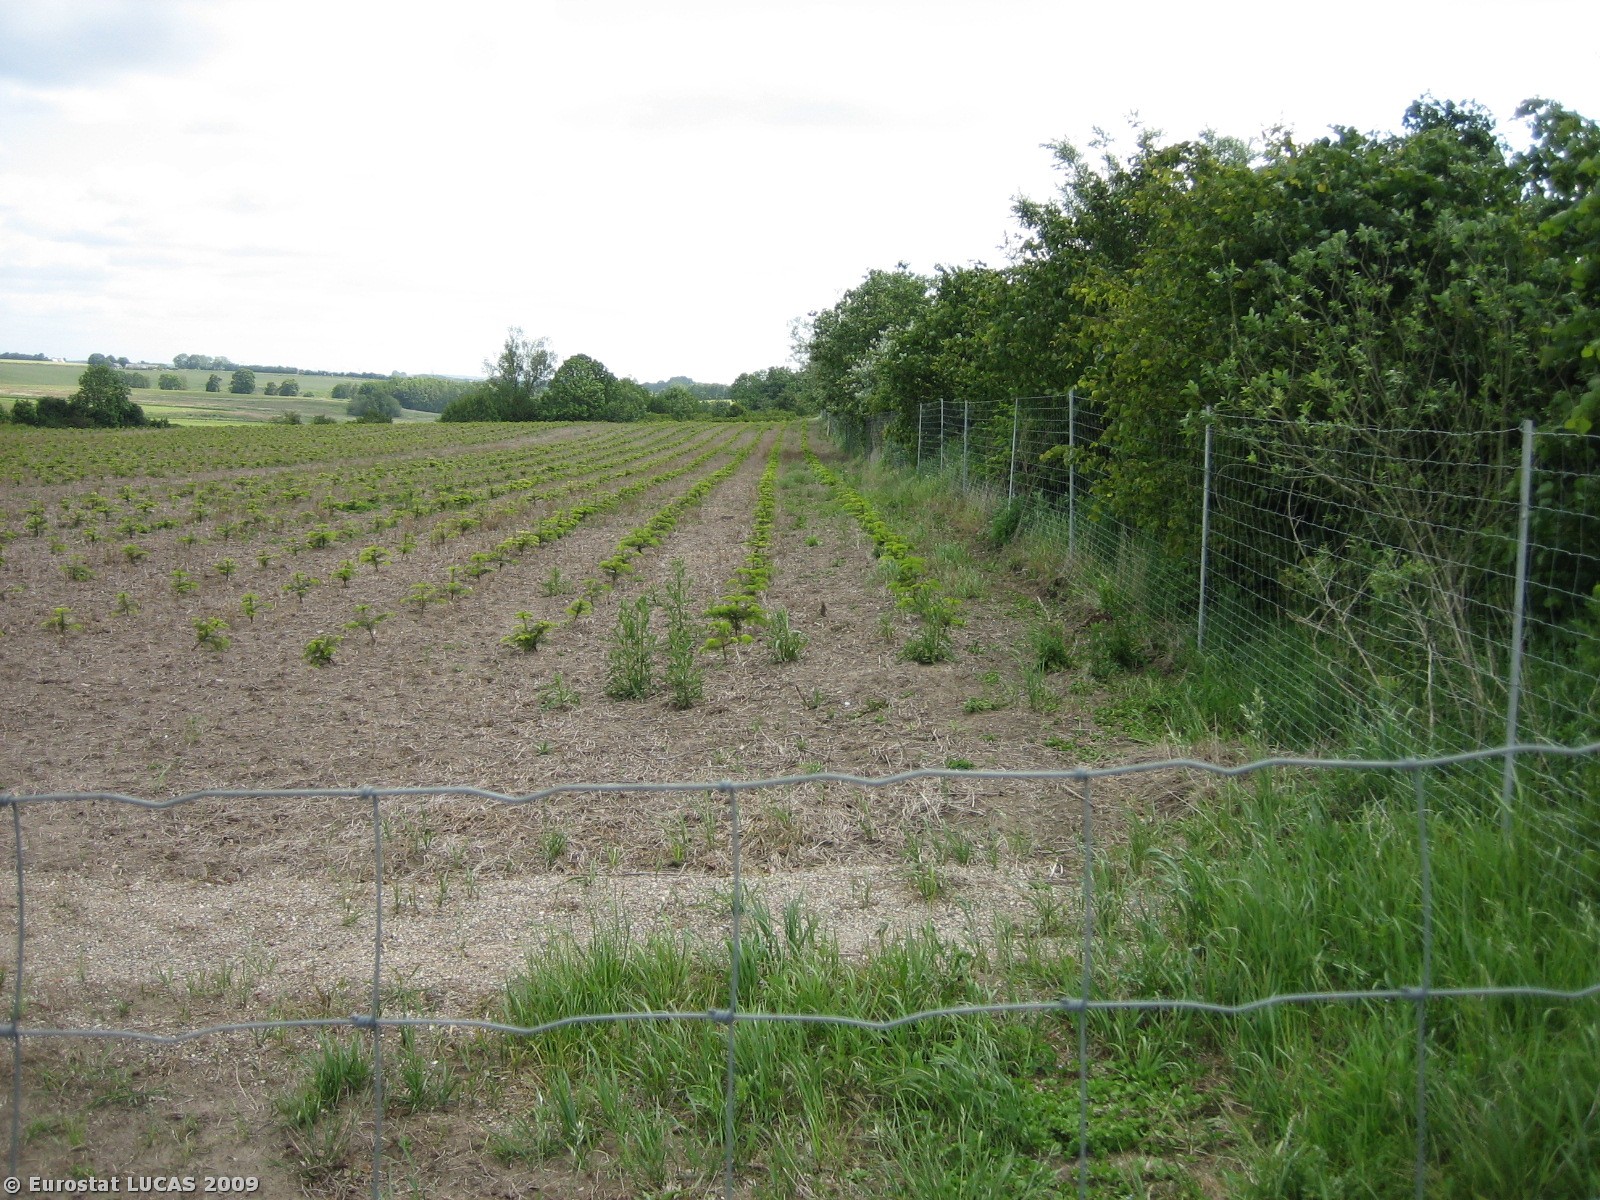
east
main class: Woodland
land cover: Coniferous woodland
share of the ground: 10 - 25 %
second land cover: Bare land
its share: > 75 %
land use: Agriculture (excluding fallow land and kitchen gardens)
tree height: < 5 m
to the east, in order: Coniferous woodland; Barley; Fences; Broadleaved woodland; Grassland without tree/shrub cover
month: June
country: DK
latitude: 55.8638
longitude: 9.6967
